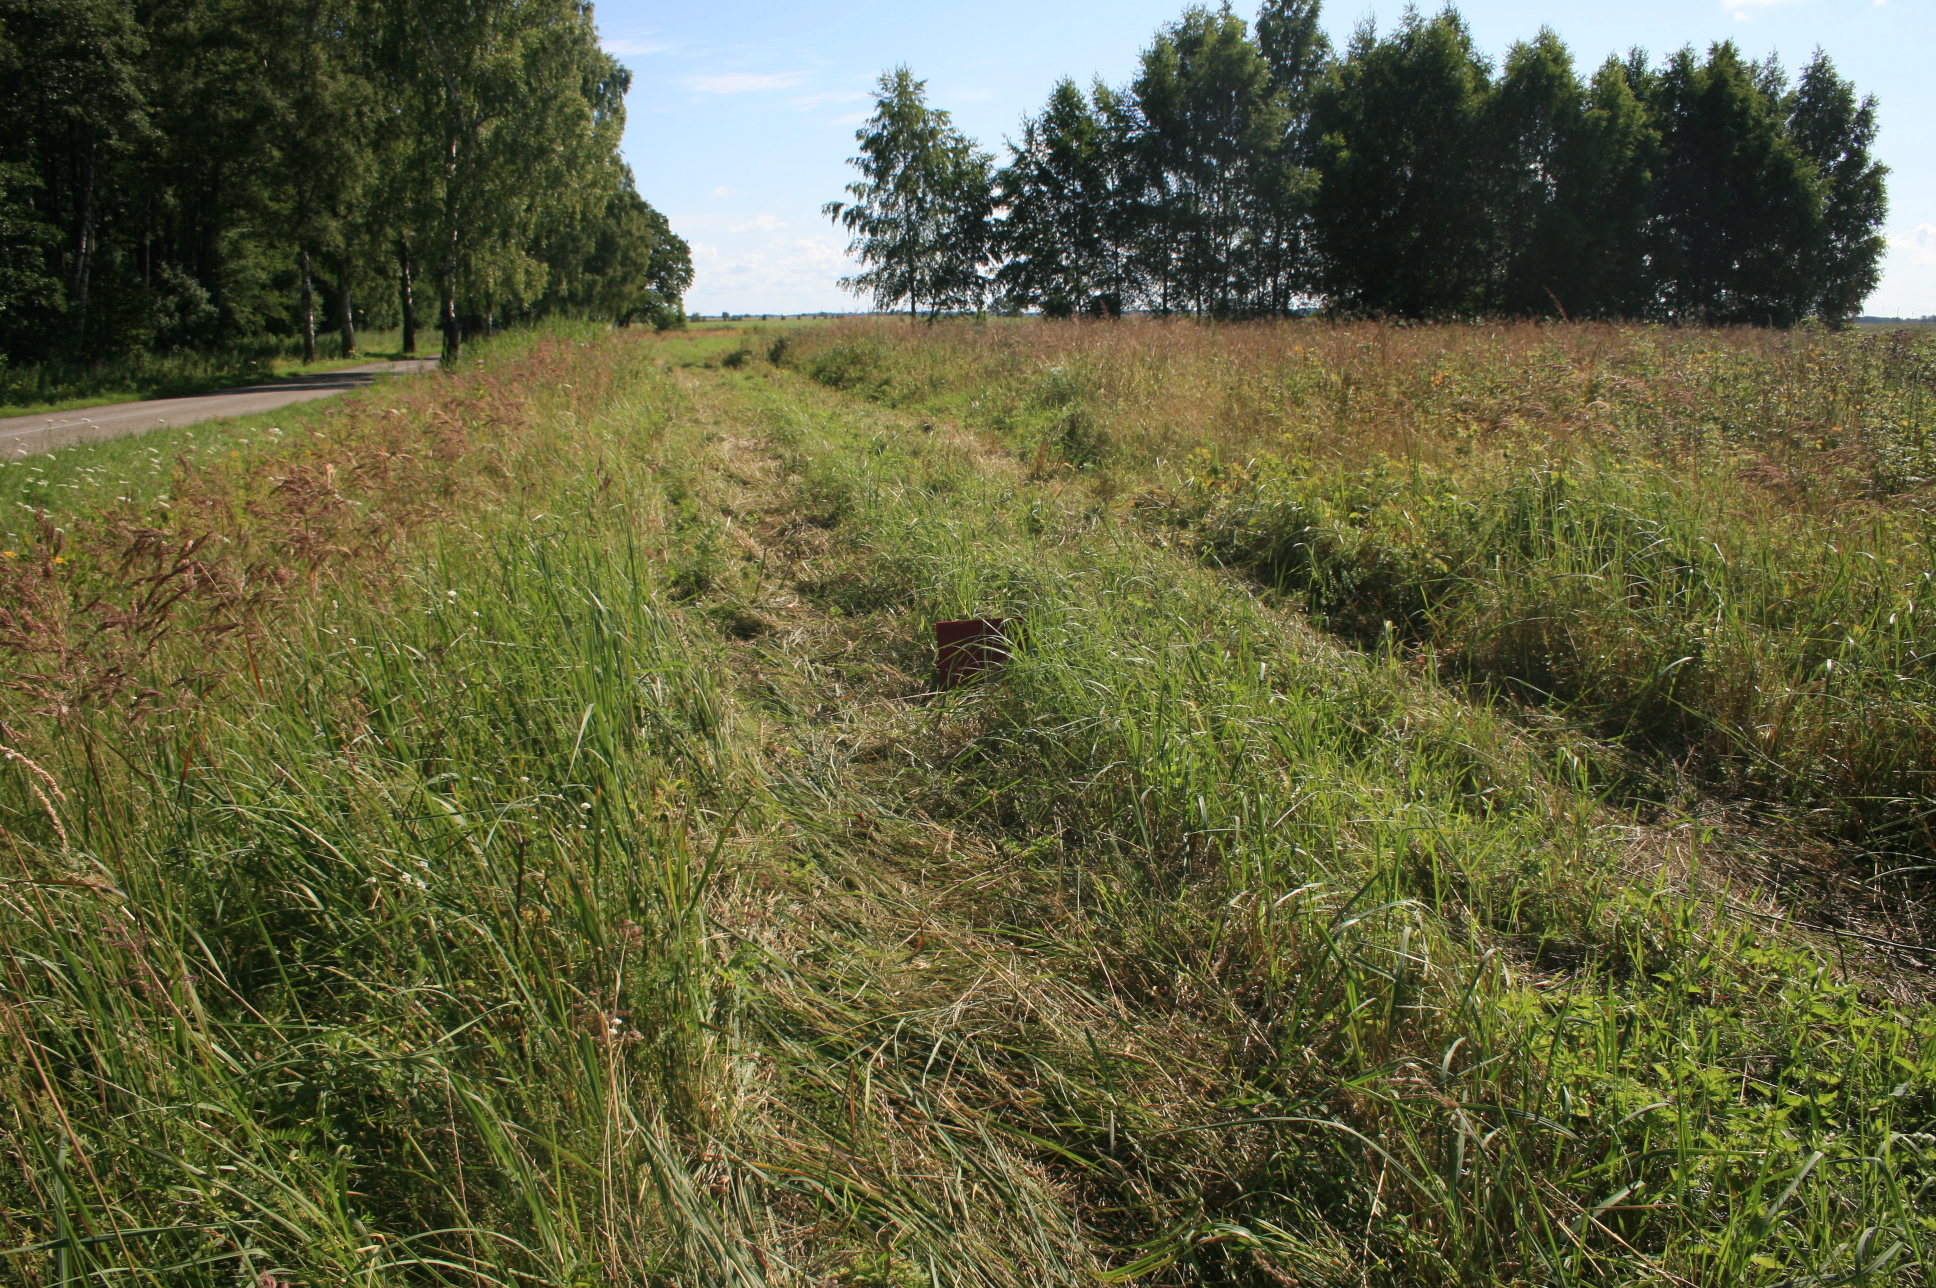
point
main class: Grassland
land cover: Spontaneously vegetated surfaces
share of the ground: > 75 %
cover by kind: herbaceous plants 100 %
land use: Agriculture (excluding fallow land and kitchen gardens)
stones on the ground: < 10 %
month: July
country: LT
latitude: 55.3839
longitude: 21.2336
